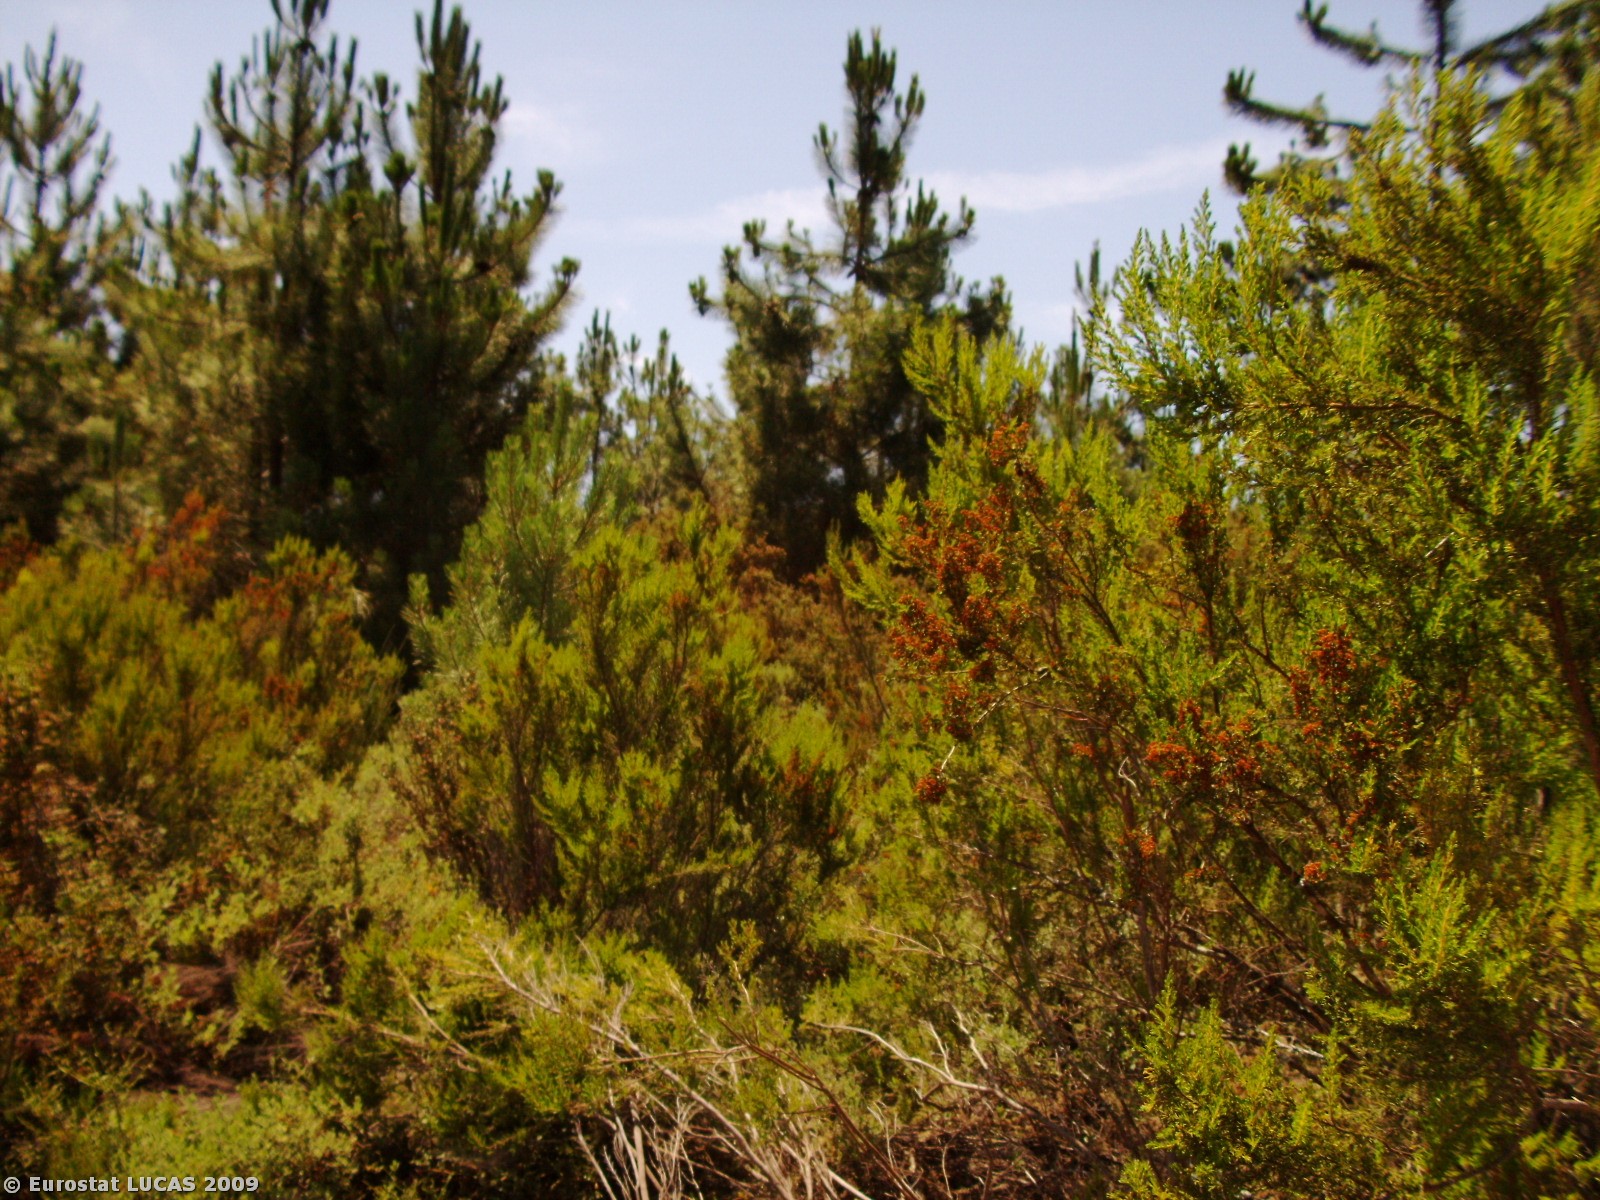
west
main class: Woodland
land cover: Broadleaved woodland
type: mesophytic deciduous forest
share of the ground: 25 - 50 %
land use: Forestry
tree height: > 5 m
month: July
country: PT
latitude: 40.8956
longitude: -7.7019
